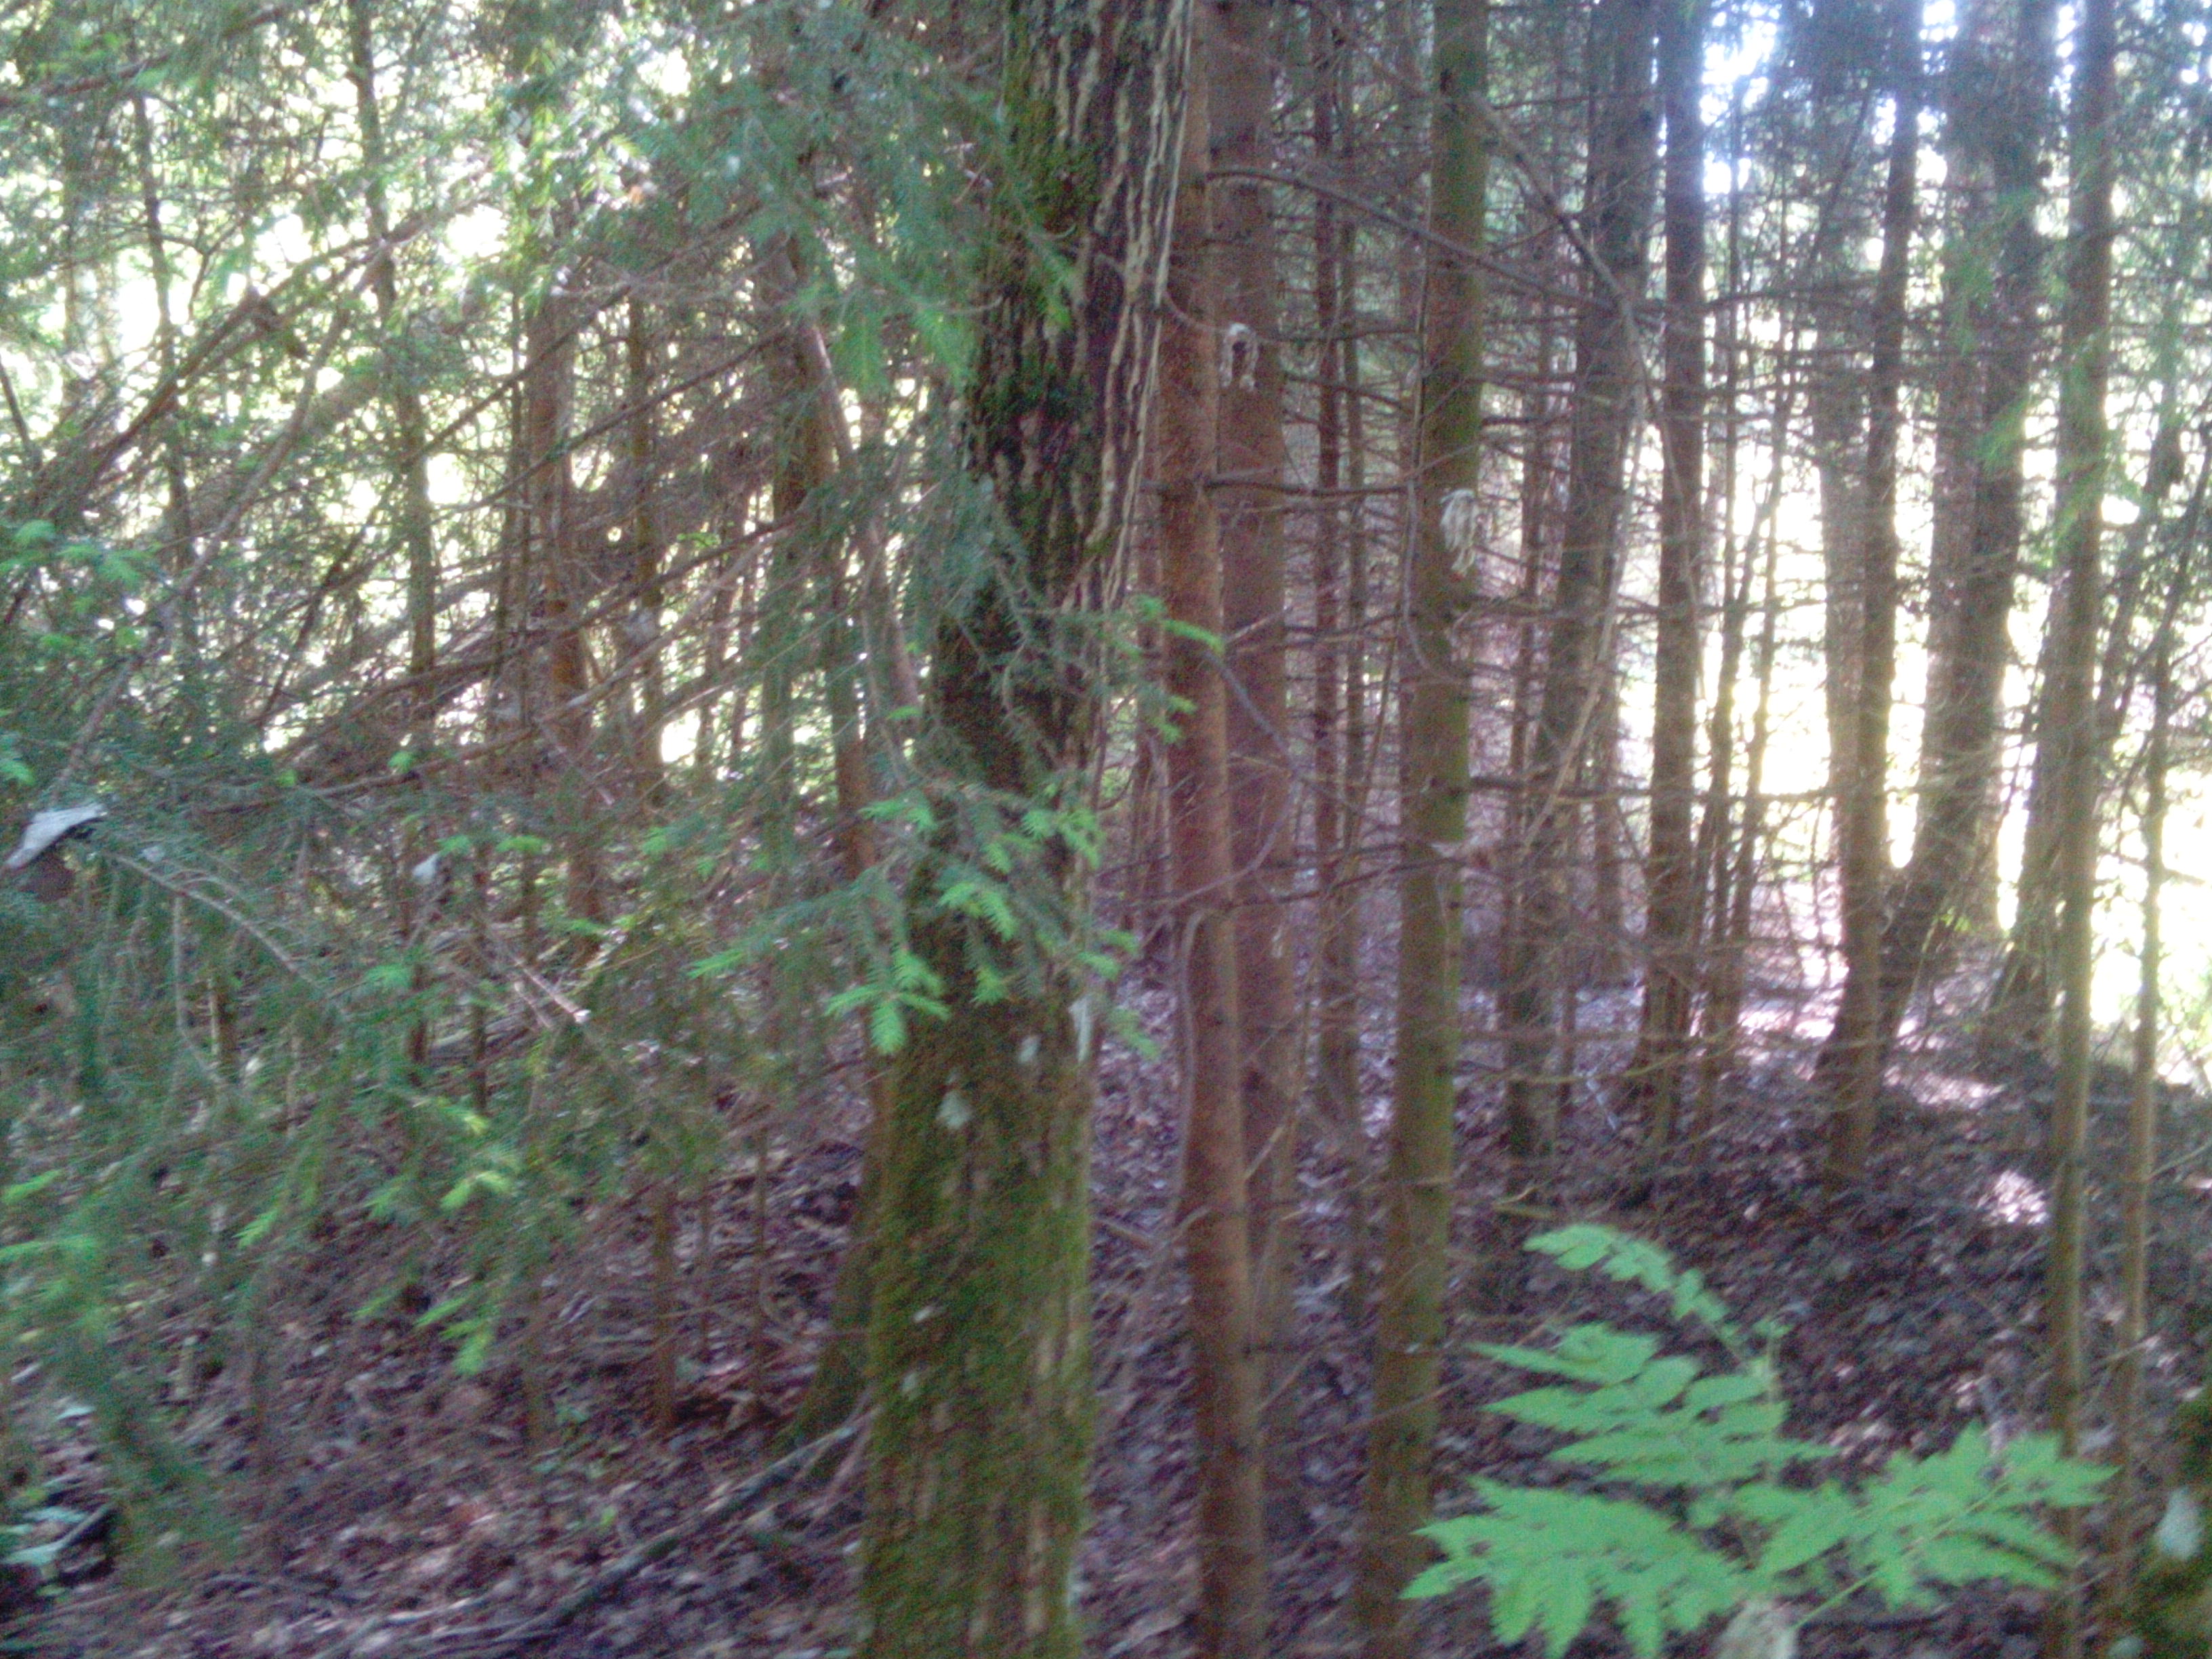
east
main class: Woodland
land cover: Spruce dominated mixed woodland
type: hemiboreal forest and nemoral coniferous forest and mixed broadleaved-coniferous forest
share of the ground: > 75 %
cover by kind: broadleaved forest trees 55 %, coniferous forest trees 40 %, shrubs 5 %
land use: Forestry
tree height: > 5 m
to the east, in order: Spruce dominated mixed woodland; Broadleaved woodland; Electric lines; Broadleaved woodland; Spruce dominated mixed woodland; Tracks; Spruce dominated mixed woodland
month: June
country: LV
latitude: 56.6710
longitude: 21.8781
